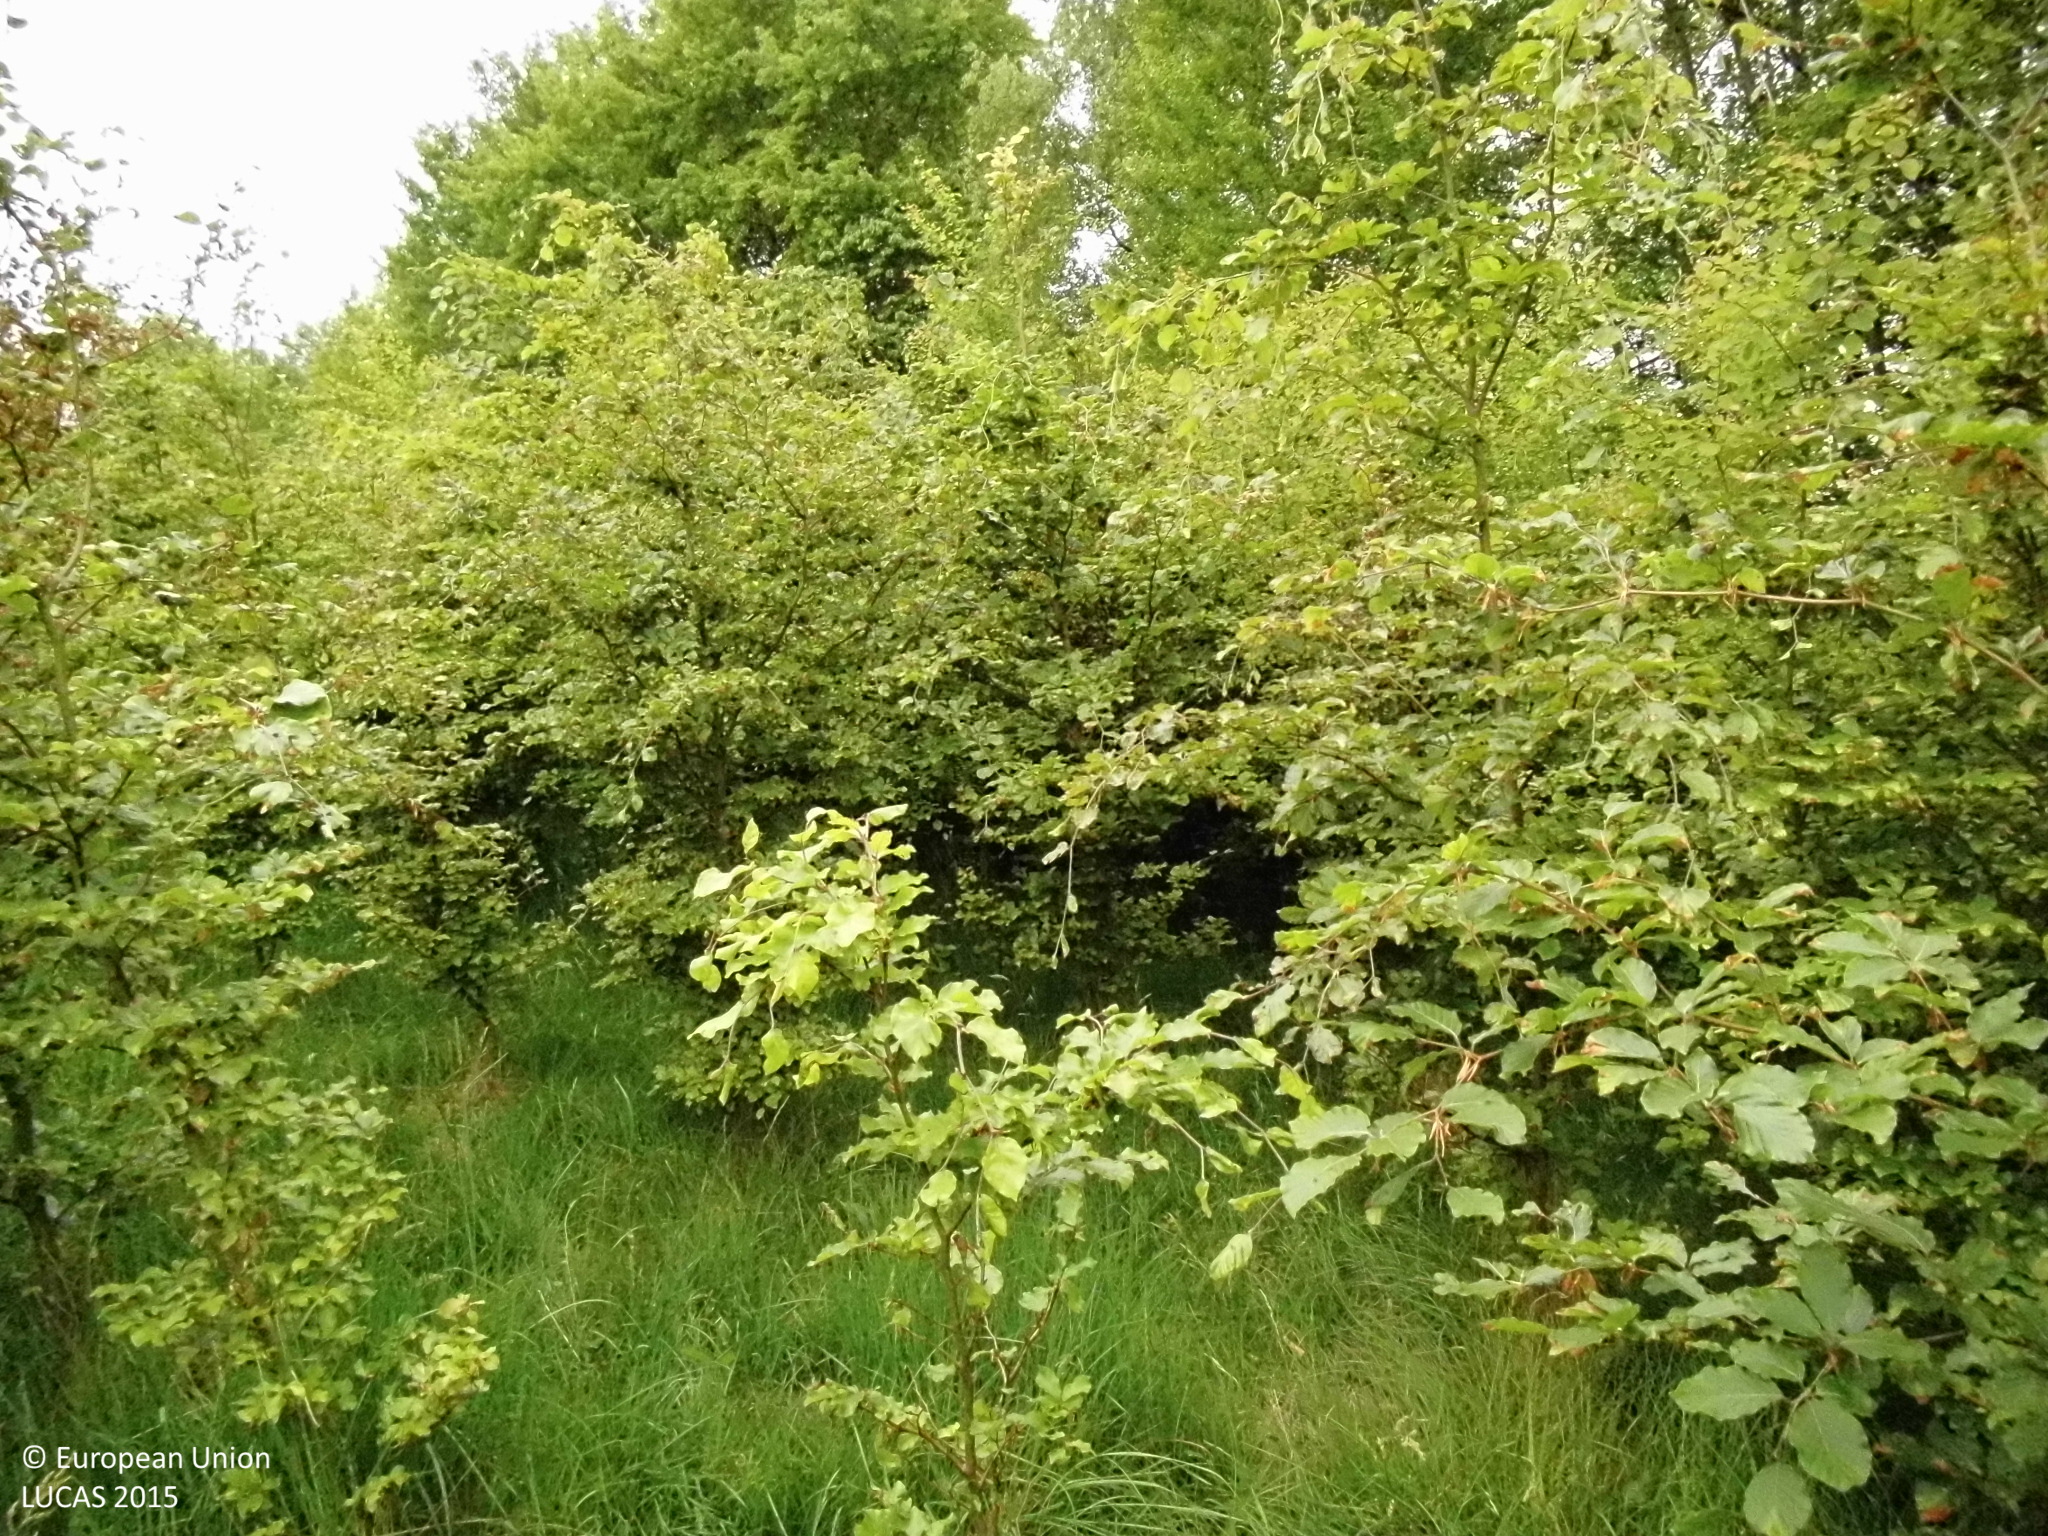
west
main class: Woodland
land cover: Broadleaved woodland
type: mesophytic deciduous forest
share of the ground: 50 - 75 %
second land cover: Grassland without tree/shrub cover
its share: > 75 %
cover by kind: broadleaved forest trees 65 %, herbaceous plants 35 %
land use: Forestry
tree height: < 5 m
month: May
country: DE
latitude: 50.8947
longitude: 7.5122
